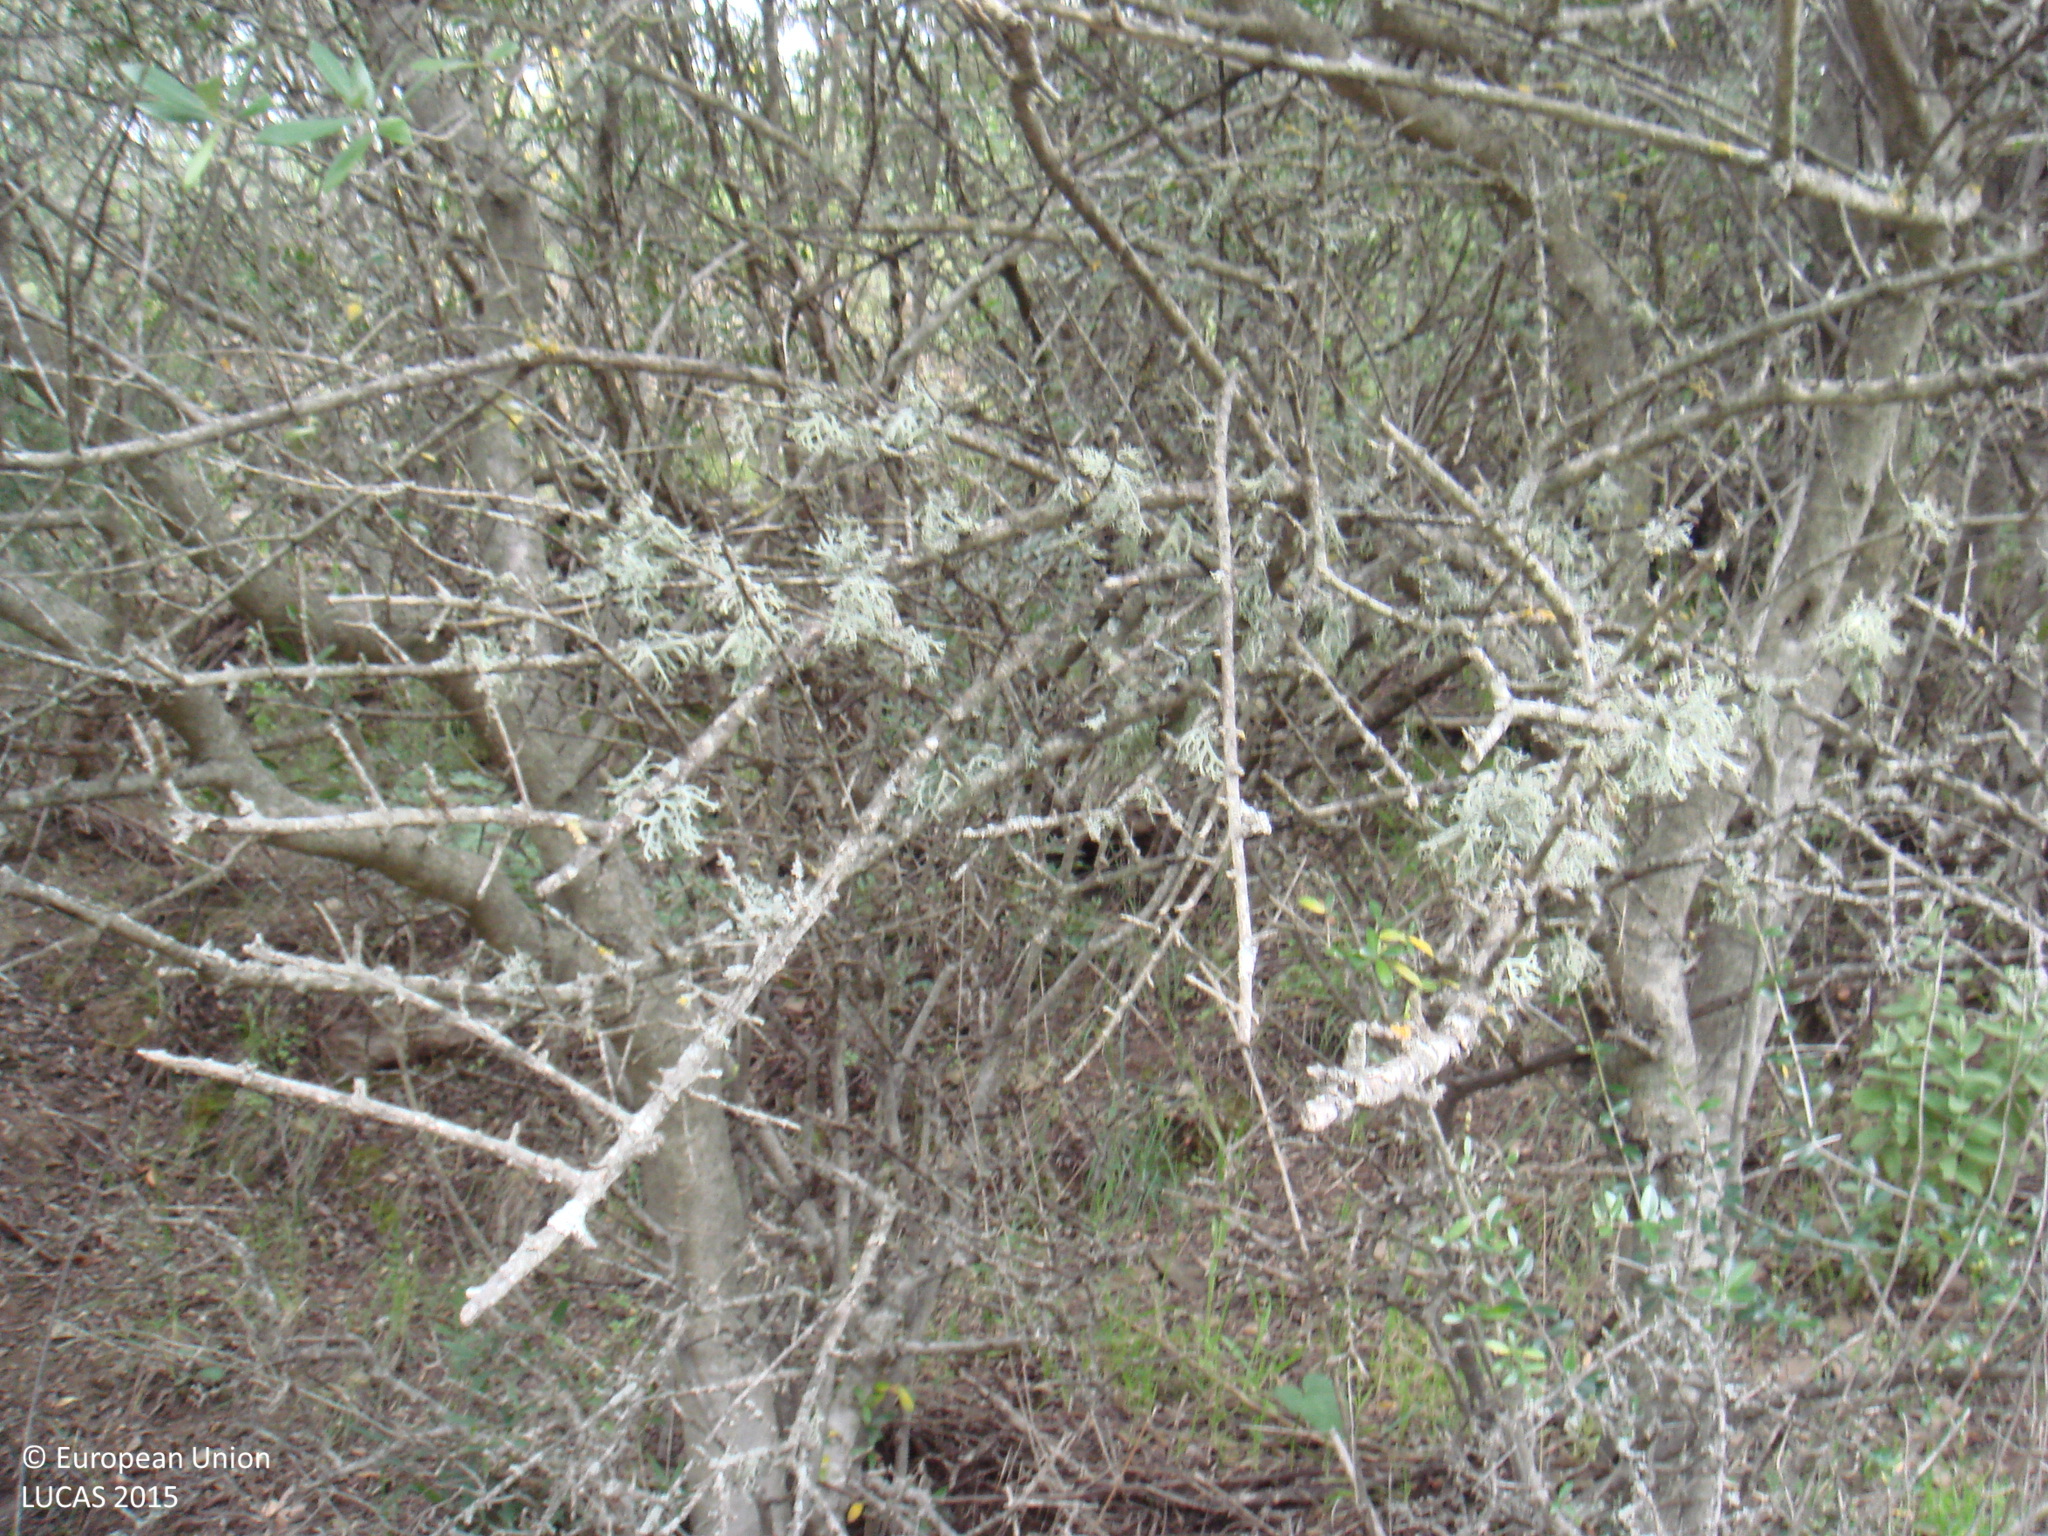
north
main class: Shrubland
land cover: Shrubland with sparse tree cover
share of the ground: 10 - 25 %
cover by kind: shrubs 55 %, herbaceous plants 40 %, broadleaved forest trees 5 %
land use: Forestry
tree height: < 5 m
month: April
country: ES
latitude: 38.0046
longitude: -5.2266
